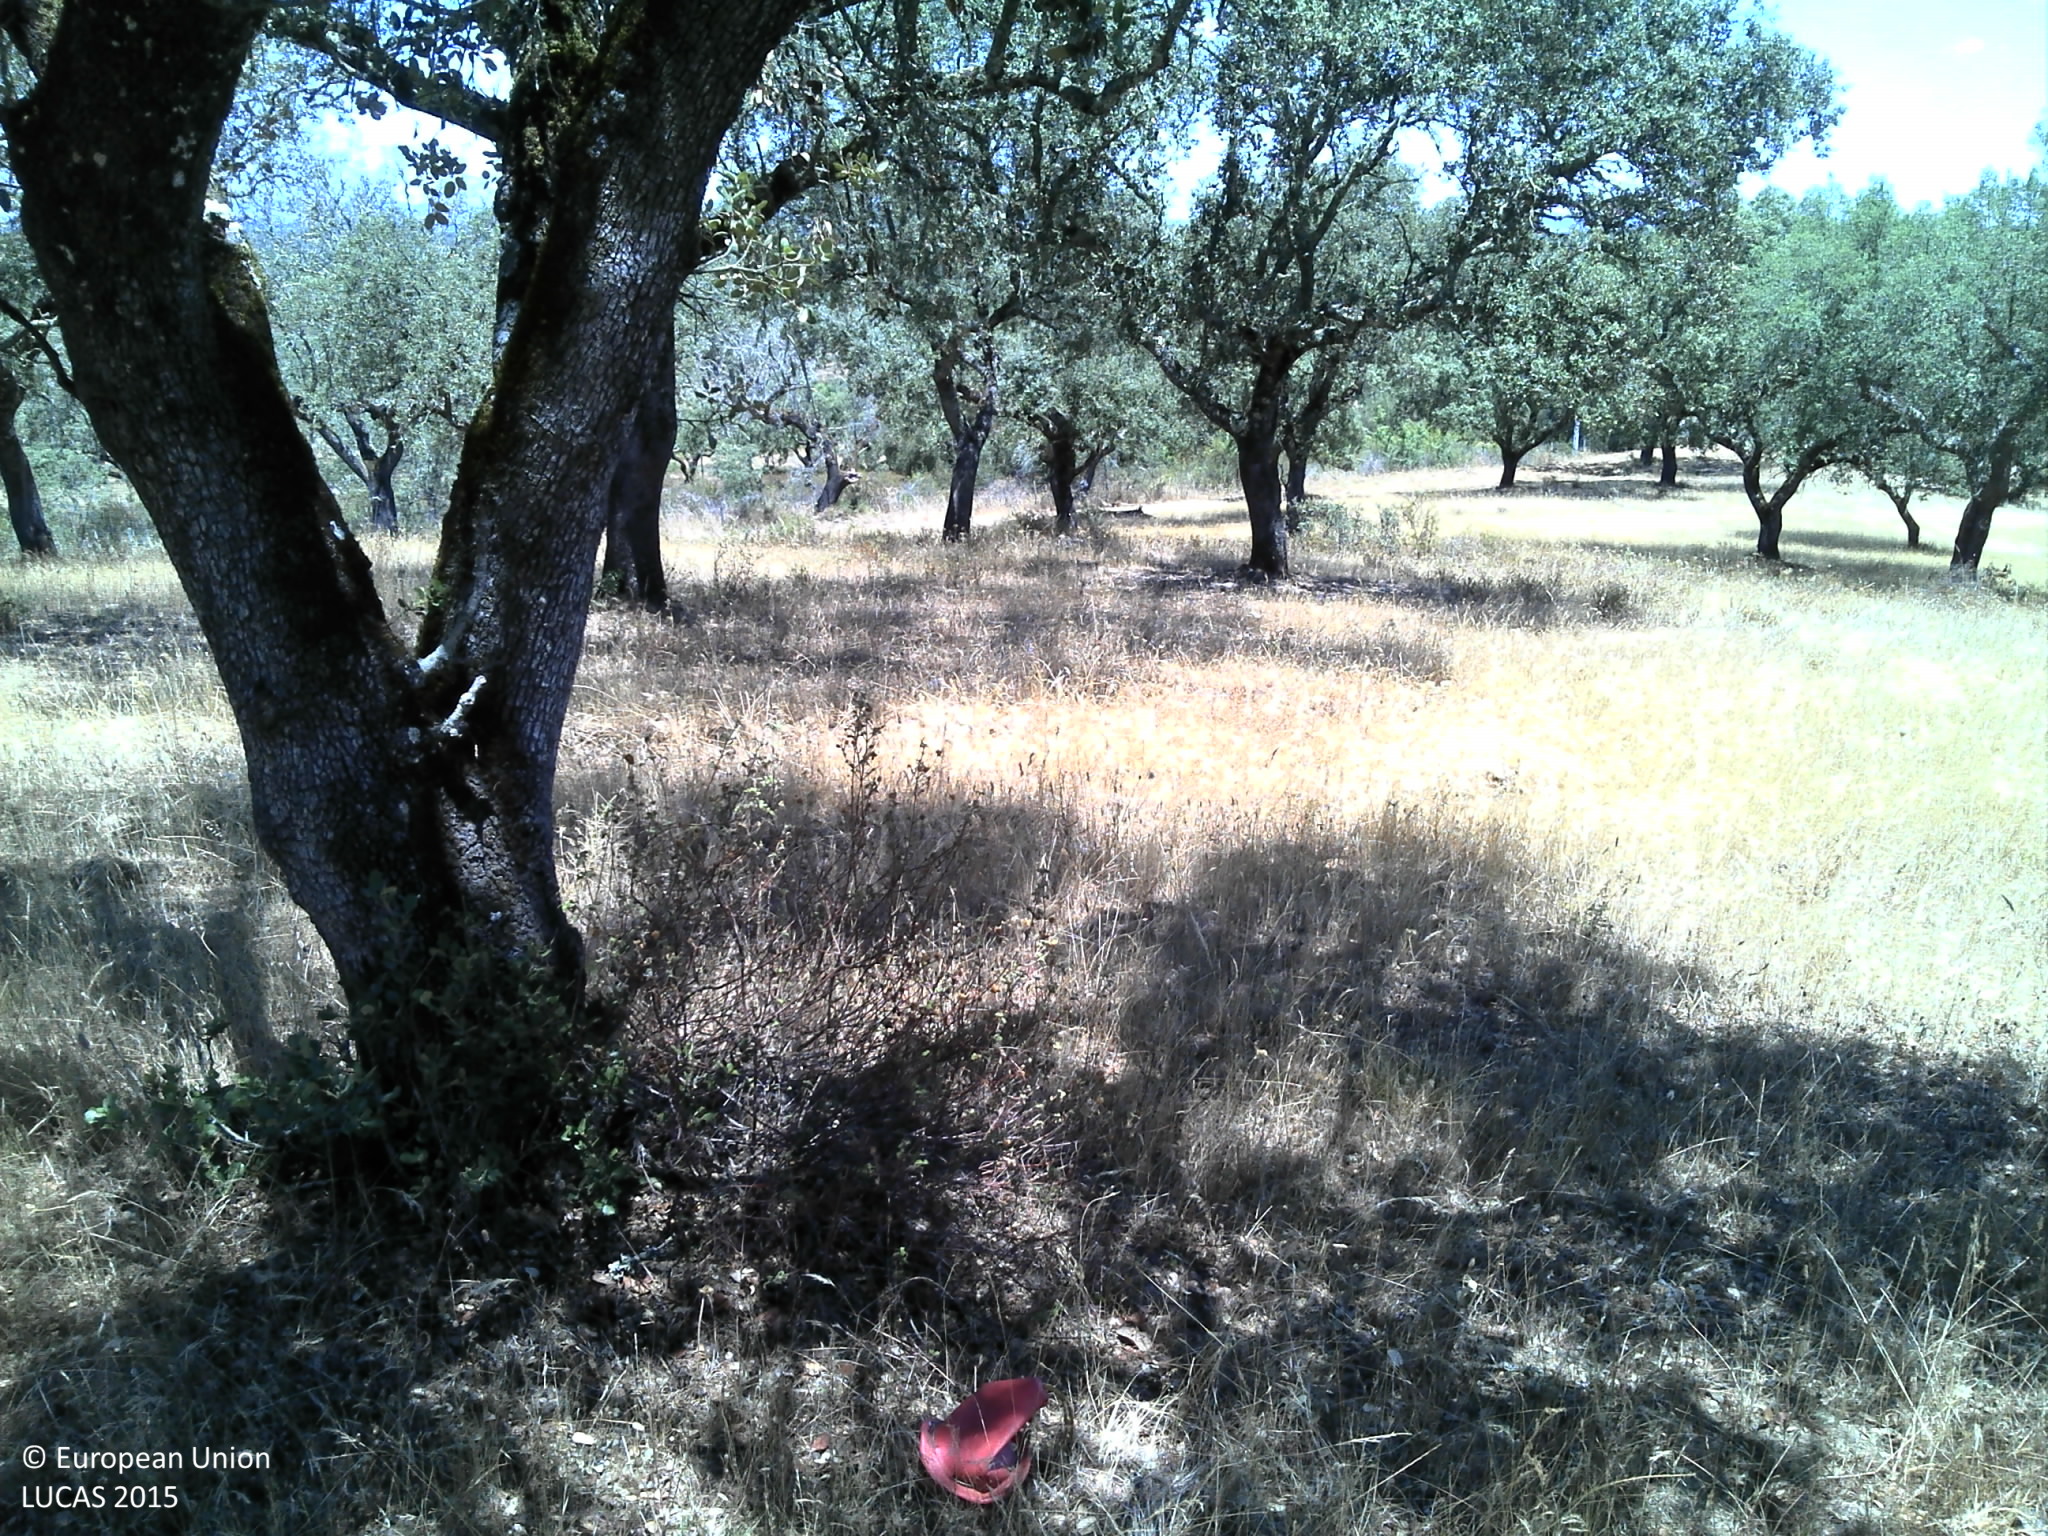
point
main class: Woodland
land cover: Broadleaved woodland
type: broadleaved evergreen forest
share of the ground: 25 - 50 %
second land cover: Grassland without tree/shrub cover
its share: 25 - 50 %
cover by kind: unconsolidated bare surface 45 %, herbaceous plants 30 %, broadleaved forest trees 25 %
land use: Forestry
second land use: Agriculture (excluding fallow land and kitchen gardens)
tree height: > 5 m
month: June
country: PT
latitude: 38.3974
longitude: -8.1211
